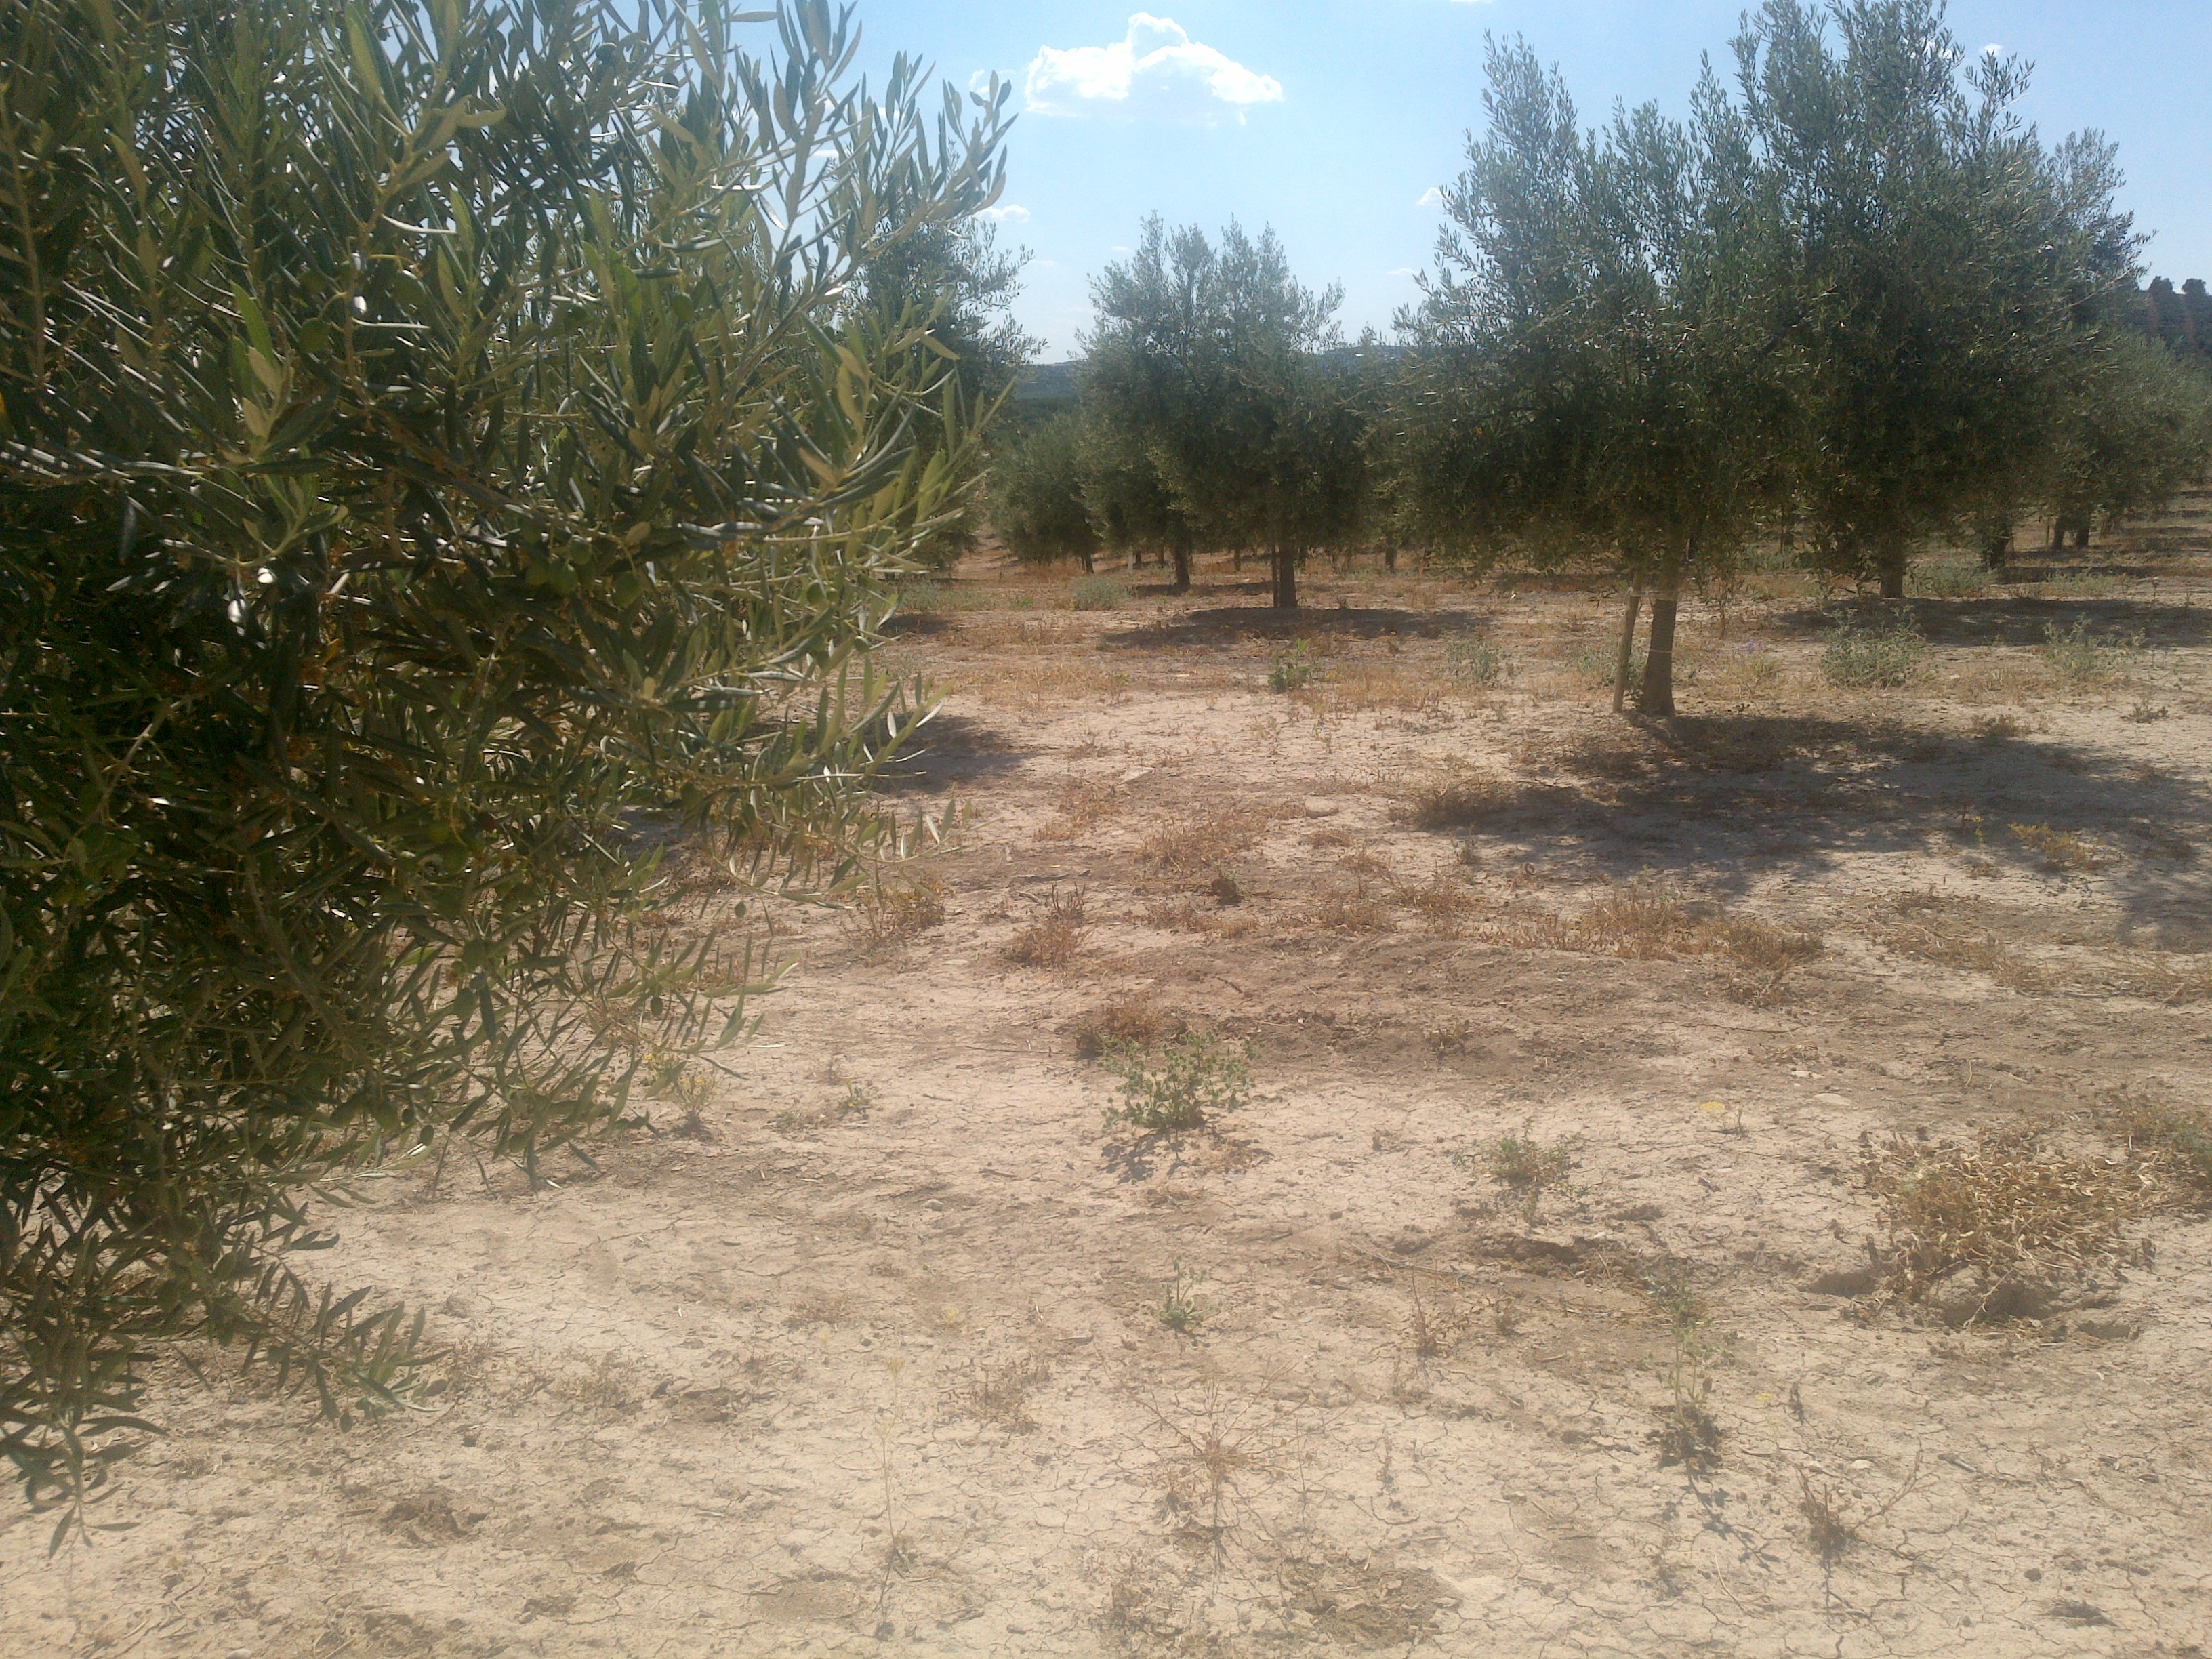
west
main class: Cropland
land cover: Olive groves
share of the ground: 10 - 25 %
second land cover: Other bare soil
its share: > 75 %
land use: Agriculture (excluding fallow land and kitchen gardens)
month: June
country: ES
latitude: 37.6926
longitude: -4.2829
